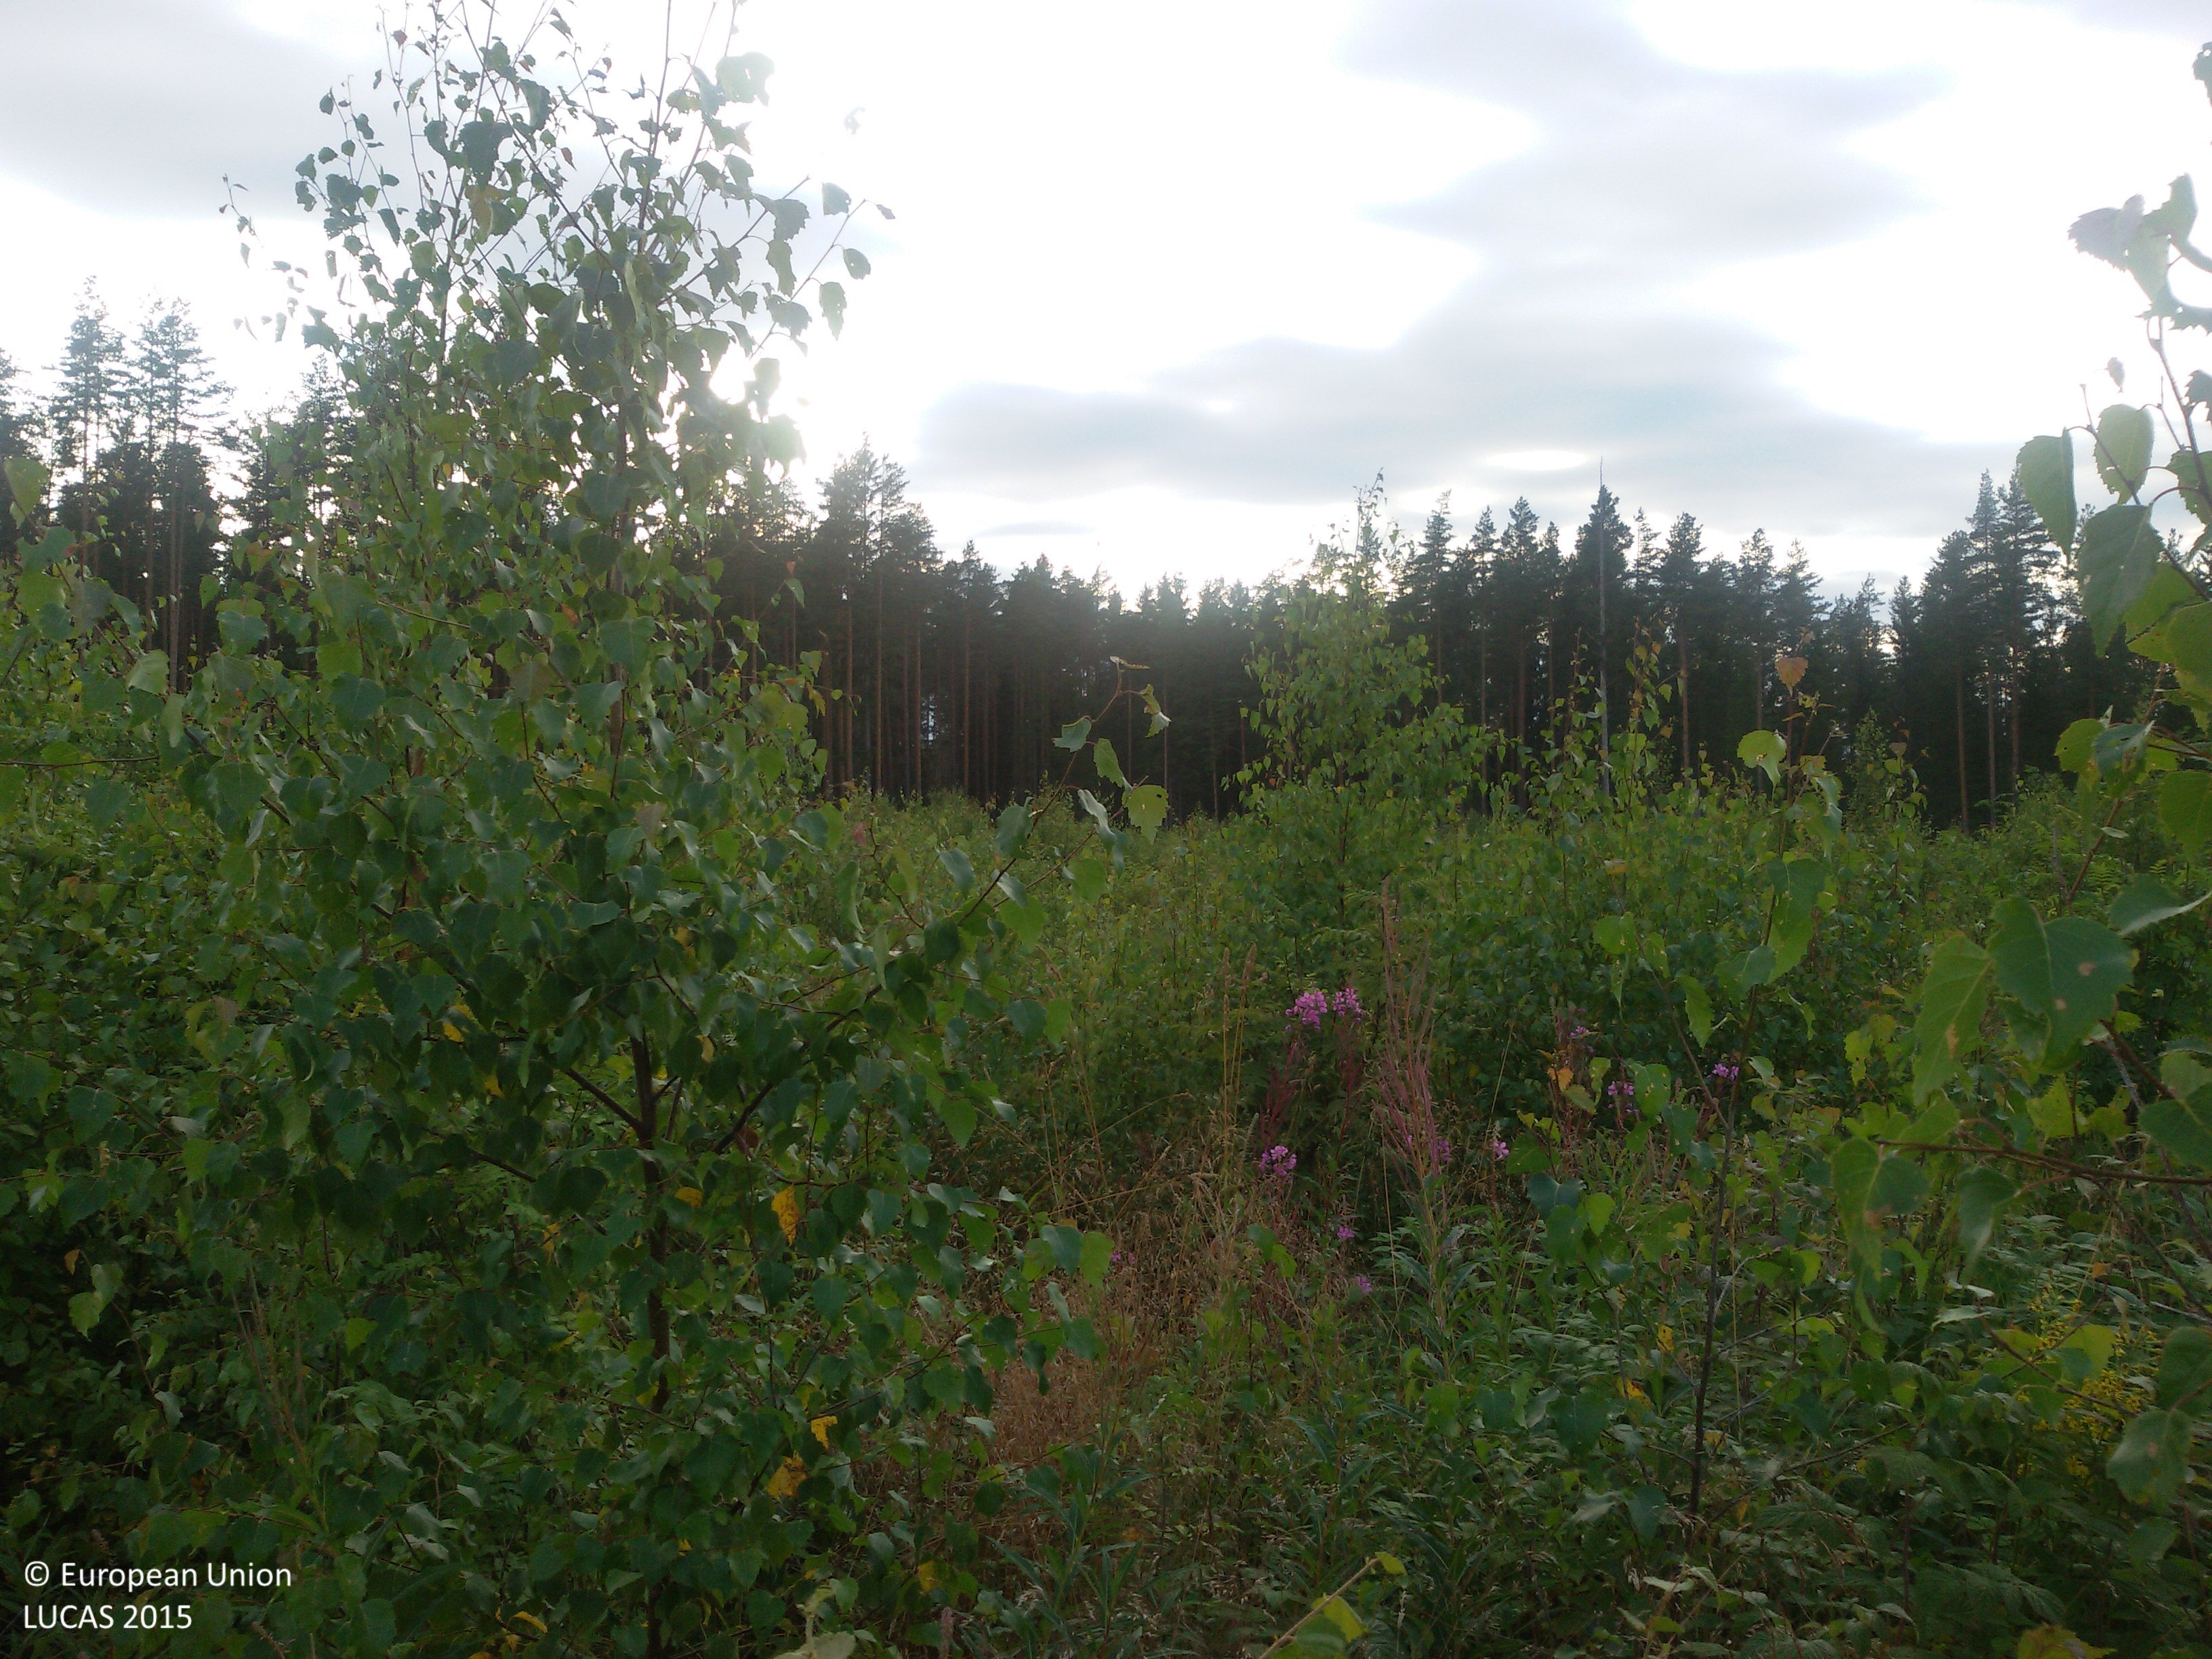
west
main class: Woodland
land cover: Broadleaved woodland
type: boreal forest
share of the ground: > 75 %
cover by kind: broadleaved forest trees 60 %, herbaceous plants 20 %, coniferous forest trees 15 %, shrubs 5 %
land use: Forestry
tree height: < 5 m
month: August
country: SE
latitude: 60.4996
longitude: 16.5243
